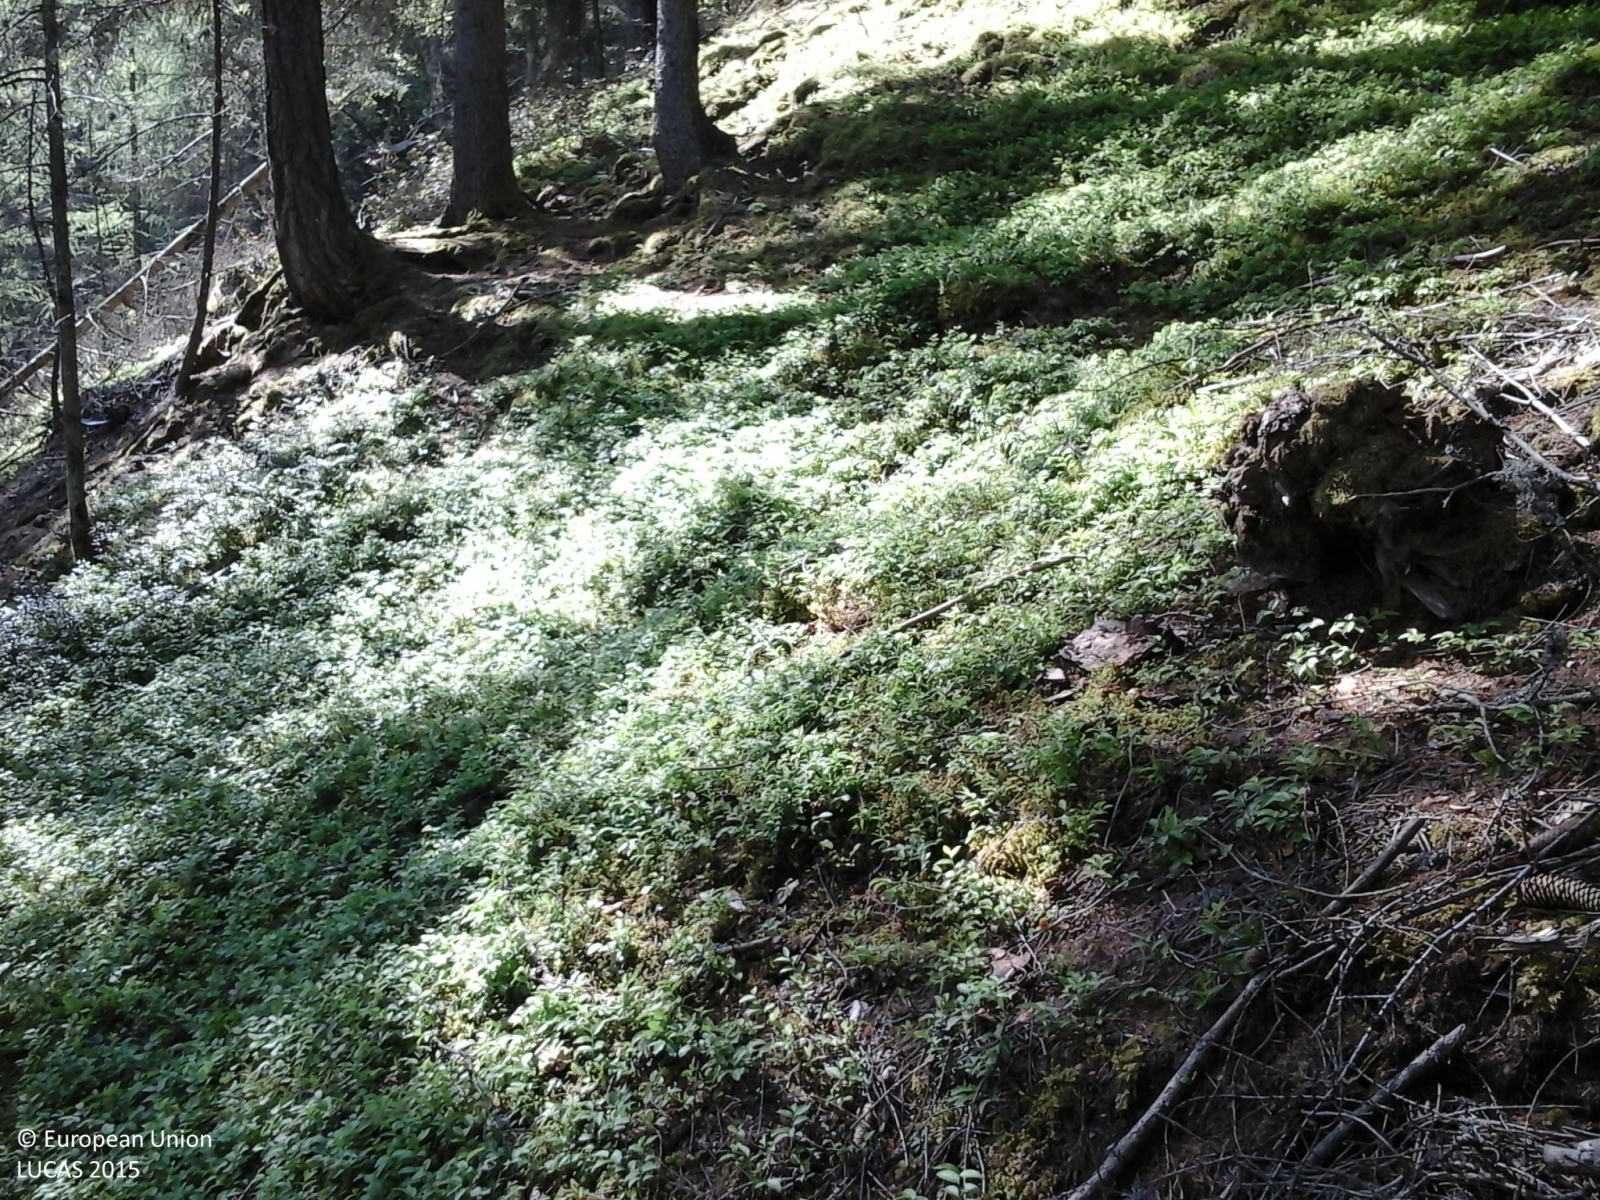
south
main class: Woodland
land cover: Spruce dominated coniferous woodland
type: alpine coniferous forest
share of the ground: > 75 %
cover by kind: coniferous forest trees 100 %
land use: Forestry
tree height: > 5 m
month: June
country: IT
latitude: 46.7076
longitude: 10.9015
